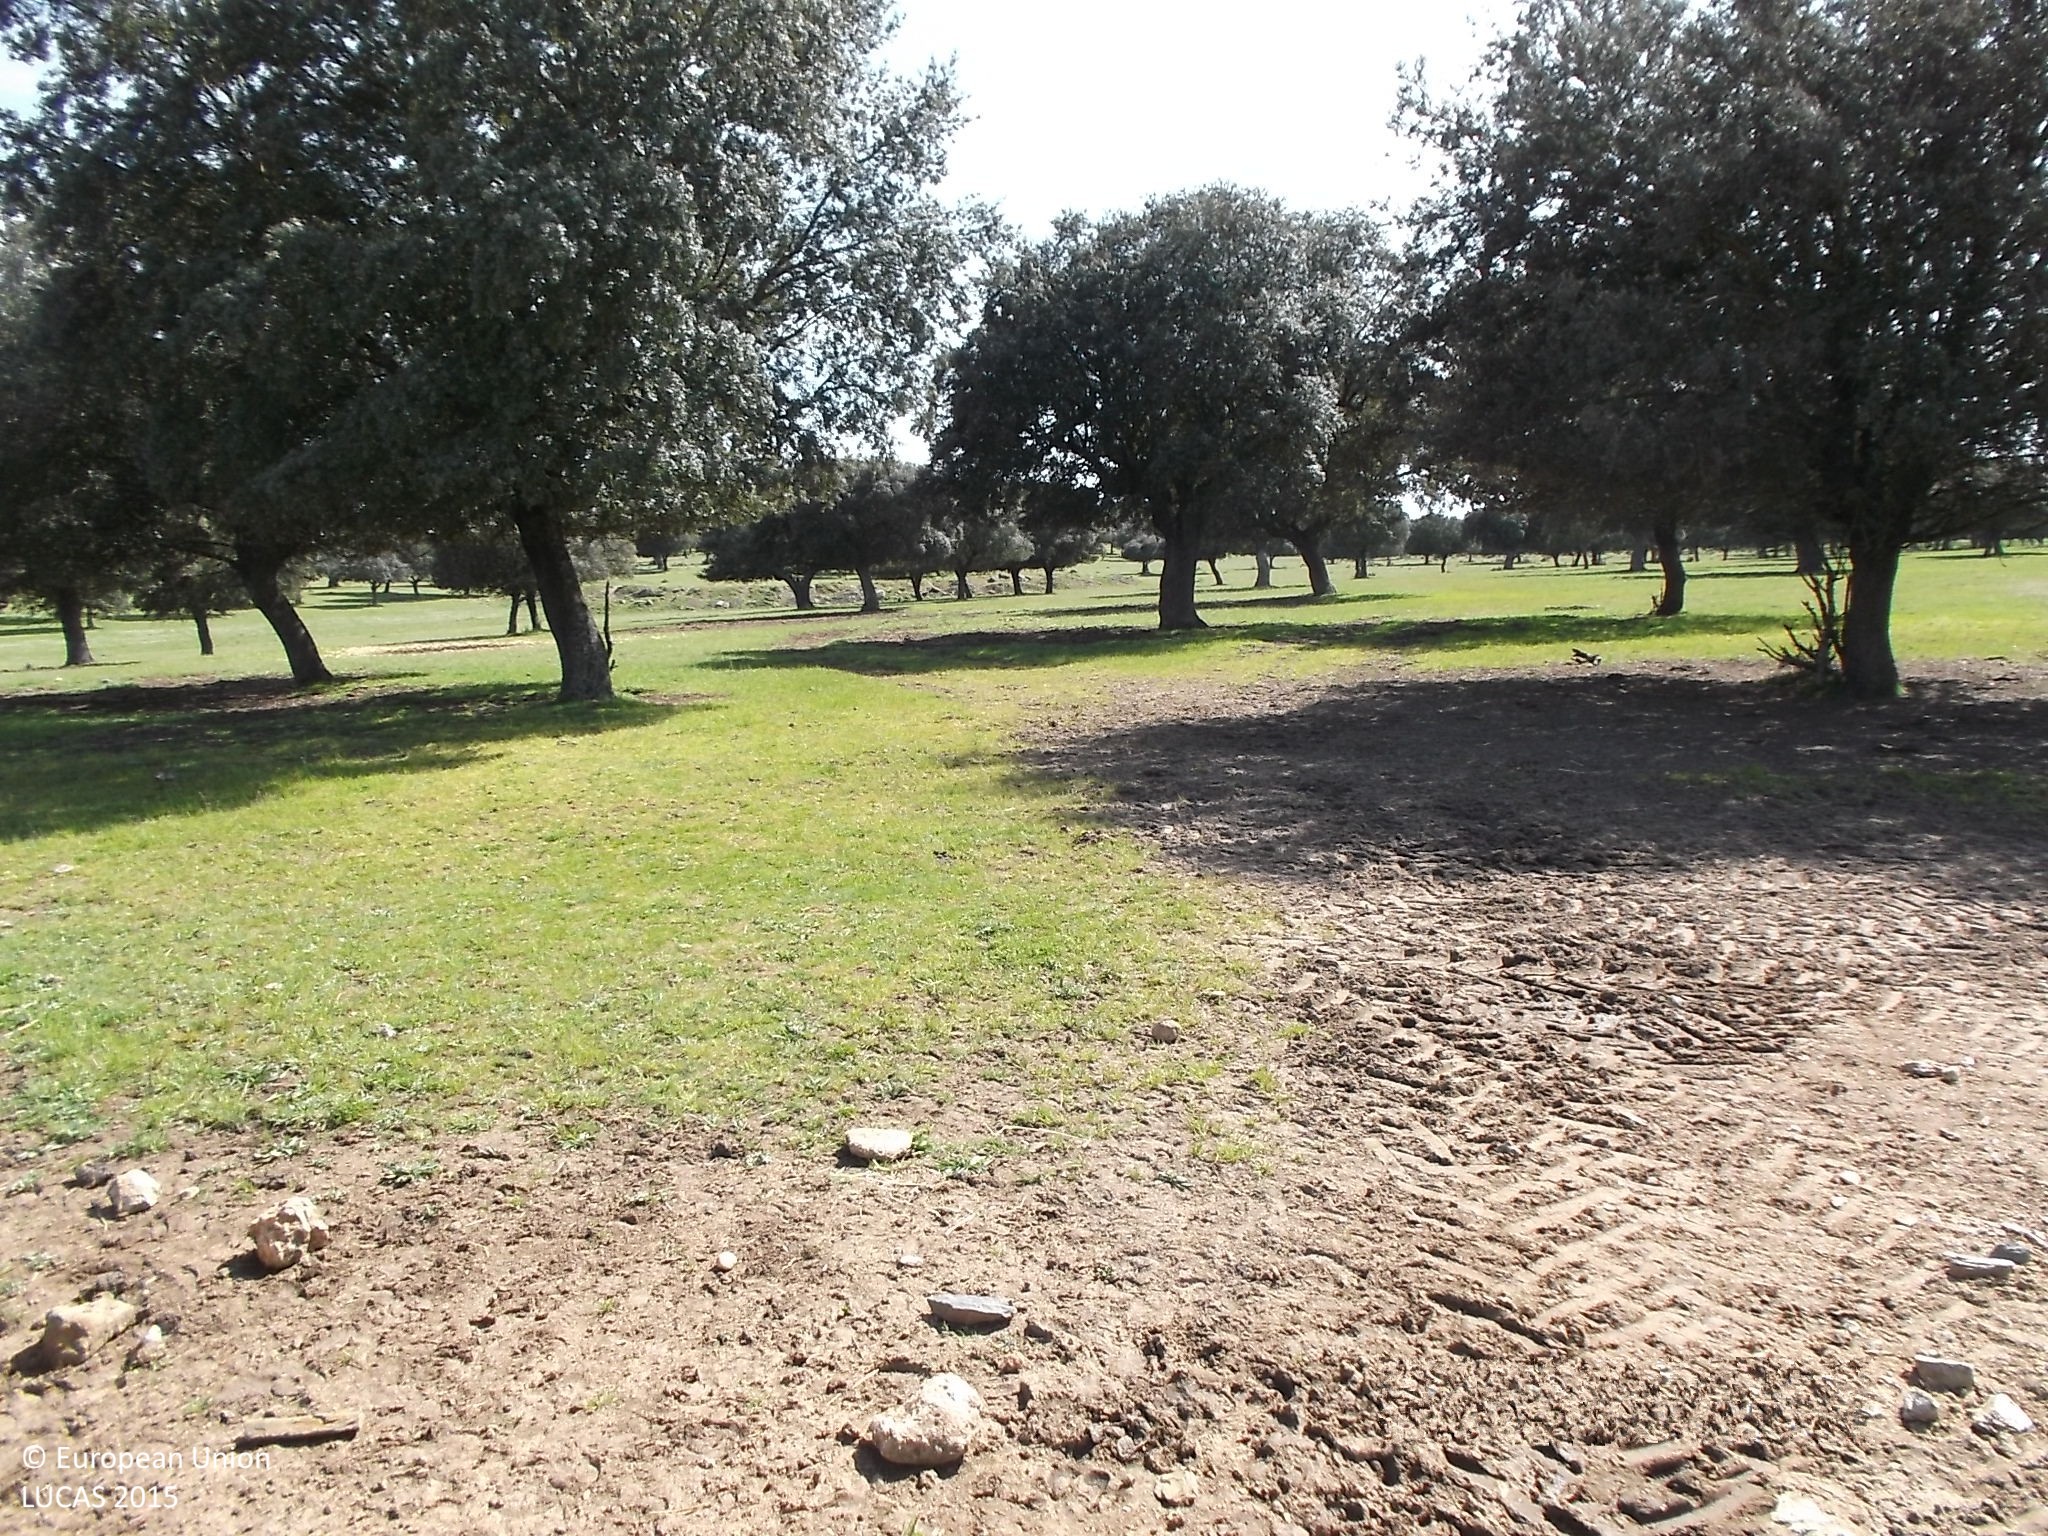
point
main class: Woodland
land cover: Broadleaved woodland
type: broadleaved evergreen forest
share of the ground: 25 - 50 %
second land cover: Grassland without tree/shrub cover
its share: 50 - 75 %
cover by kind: herbaceous plants 70 %, broadleaved forest trees 30 %
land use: Forestry
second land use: Agriculture (excluding fallow land and kitchen gardens)
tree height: > 5 m
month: April
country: ES
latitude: 40.9374
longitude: -5.9627
